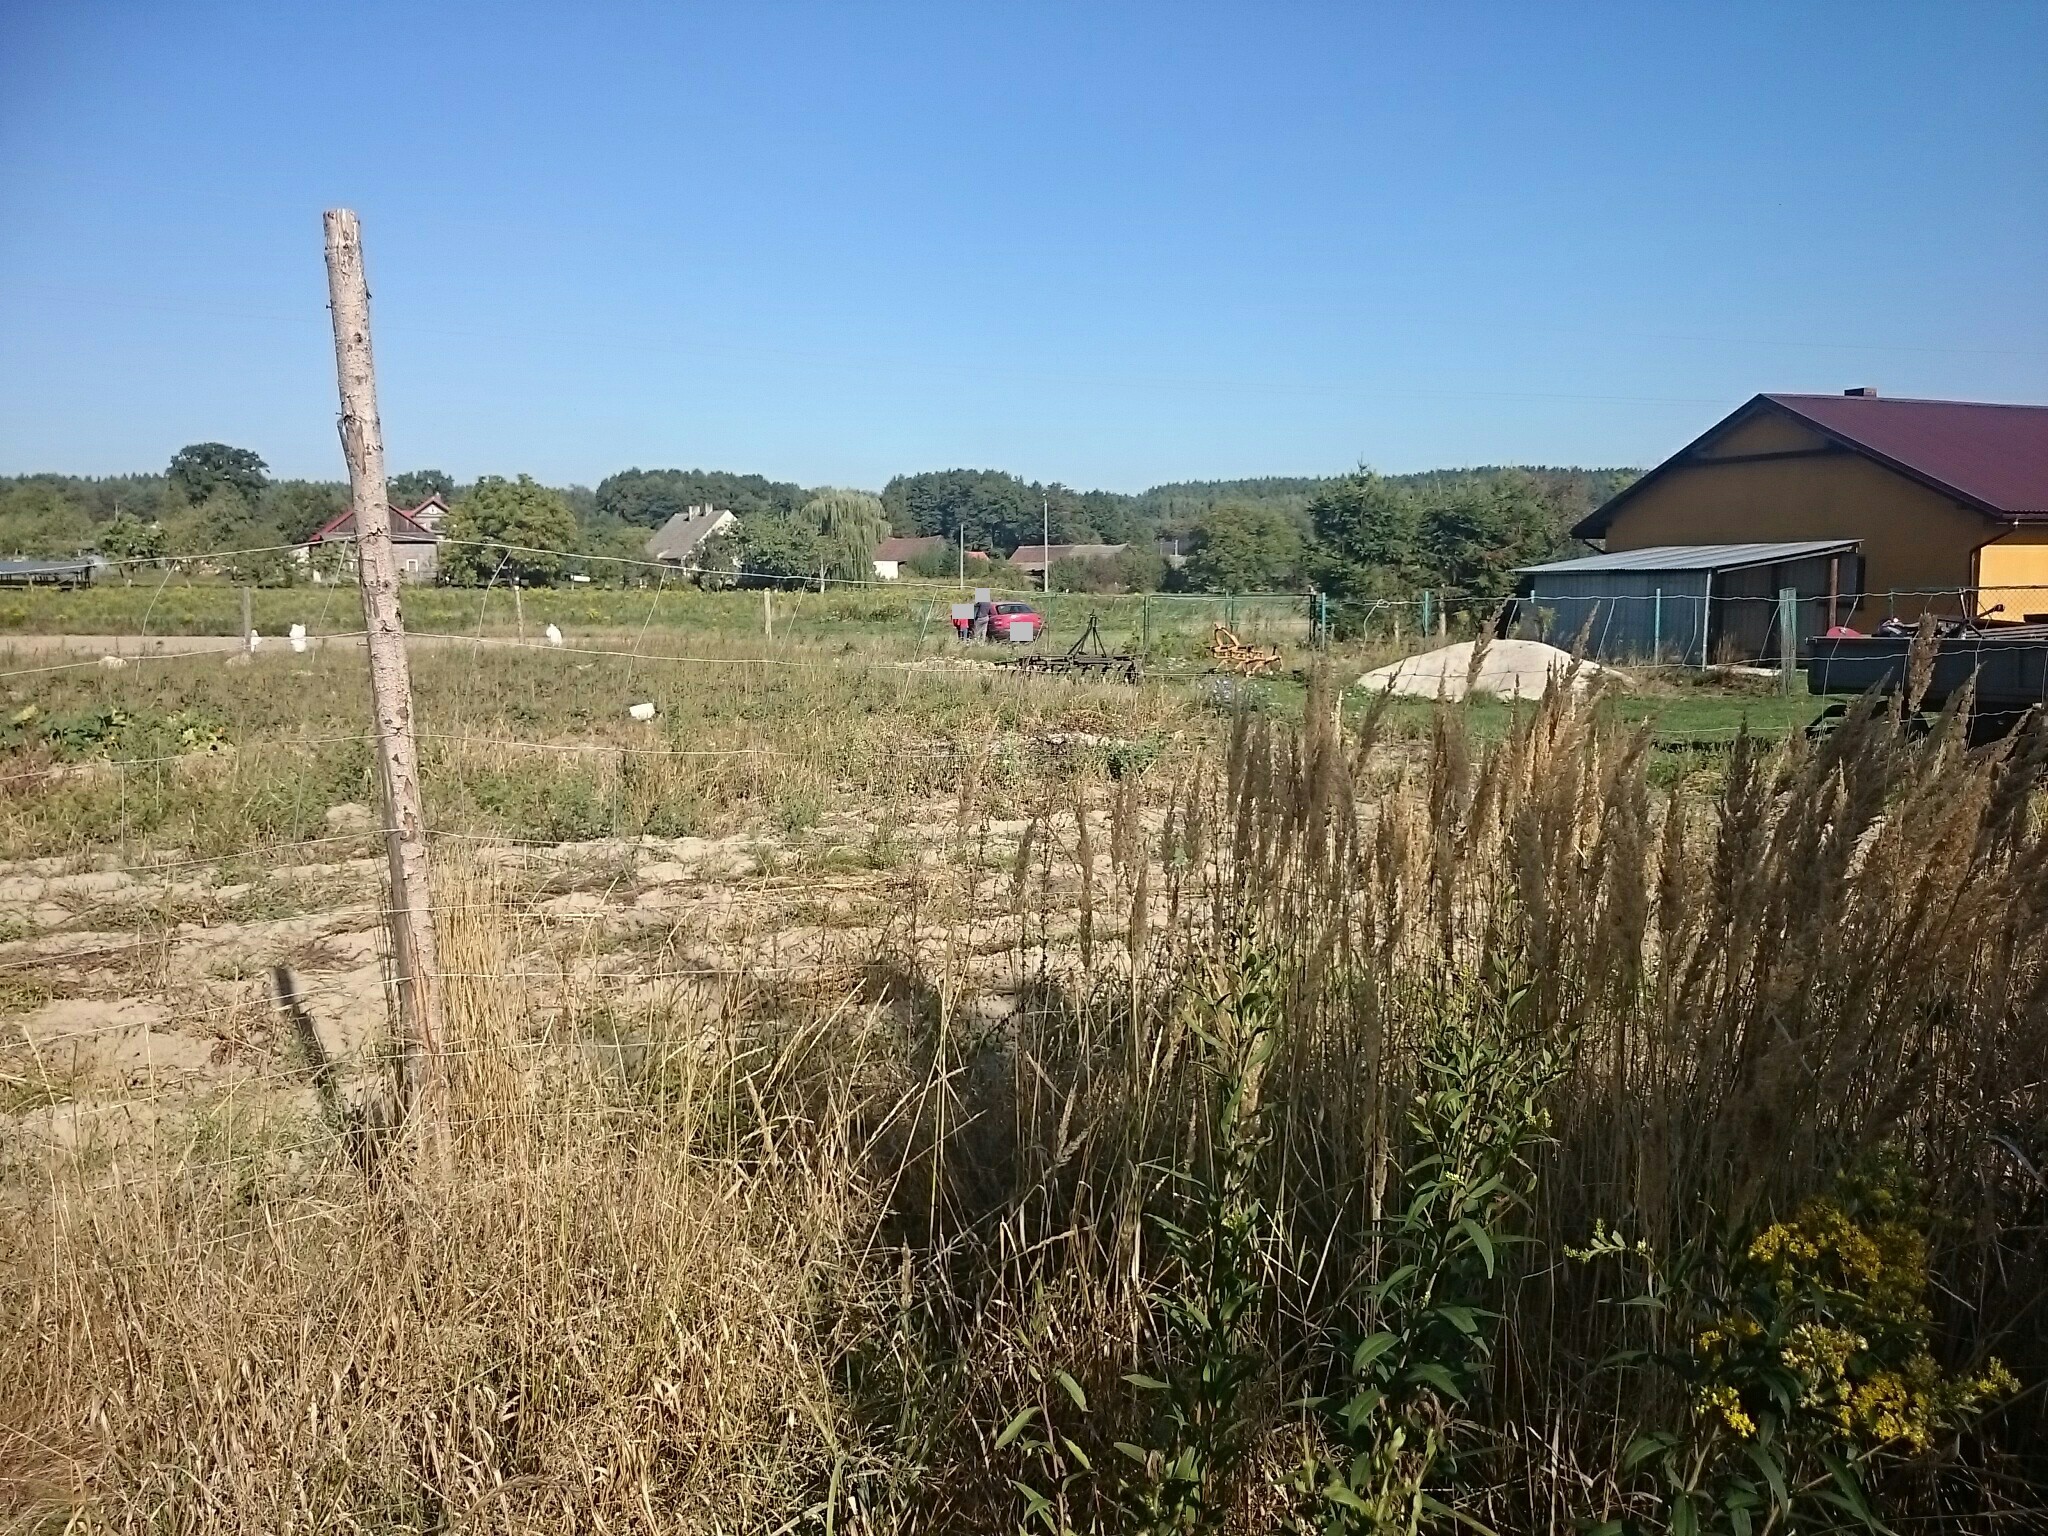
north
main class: Grassland
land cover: Grassland with sparse tree/shrub cover
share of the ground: > 75 %
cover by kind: herbaceous plants 90 %, broadleaved forest trees 5 %
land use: Semi-natural and natural areas not in use
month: September
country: PL
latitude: 51.3034
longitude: 17.3127
